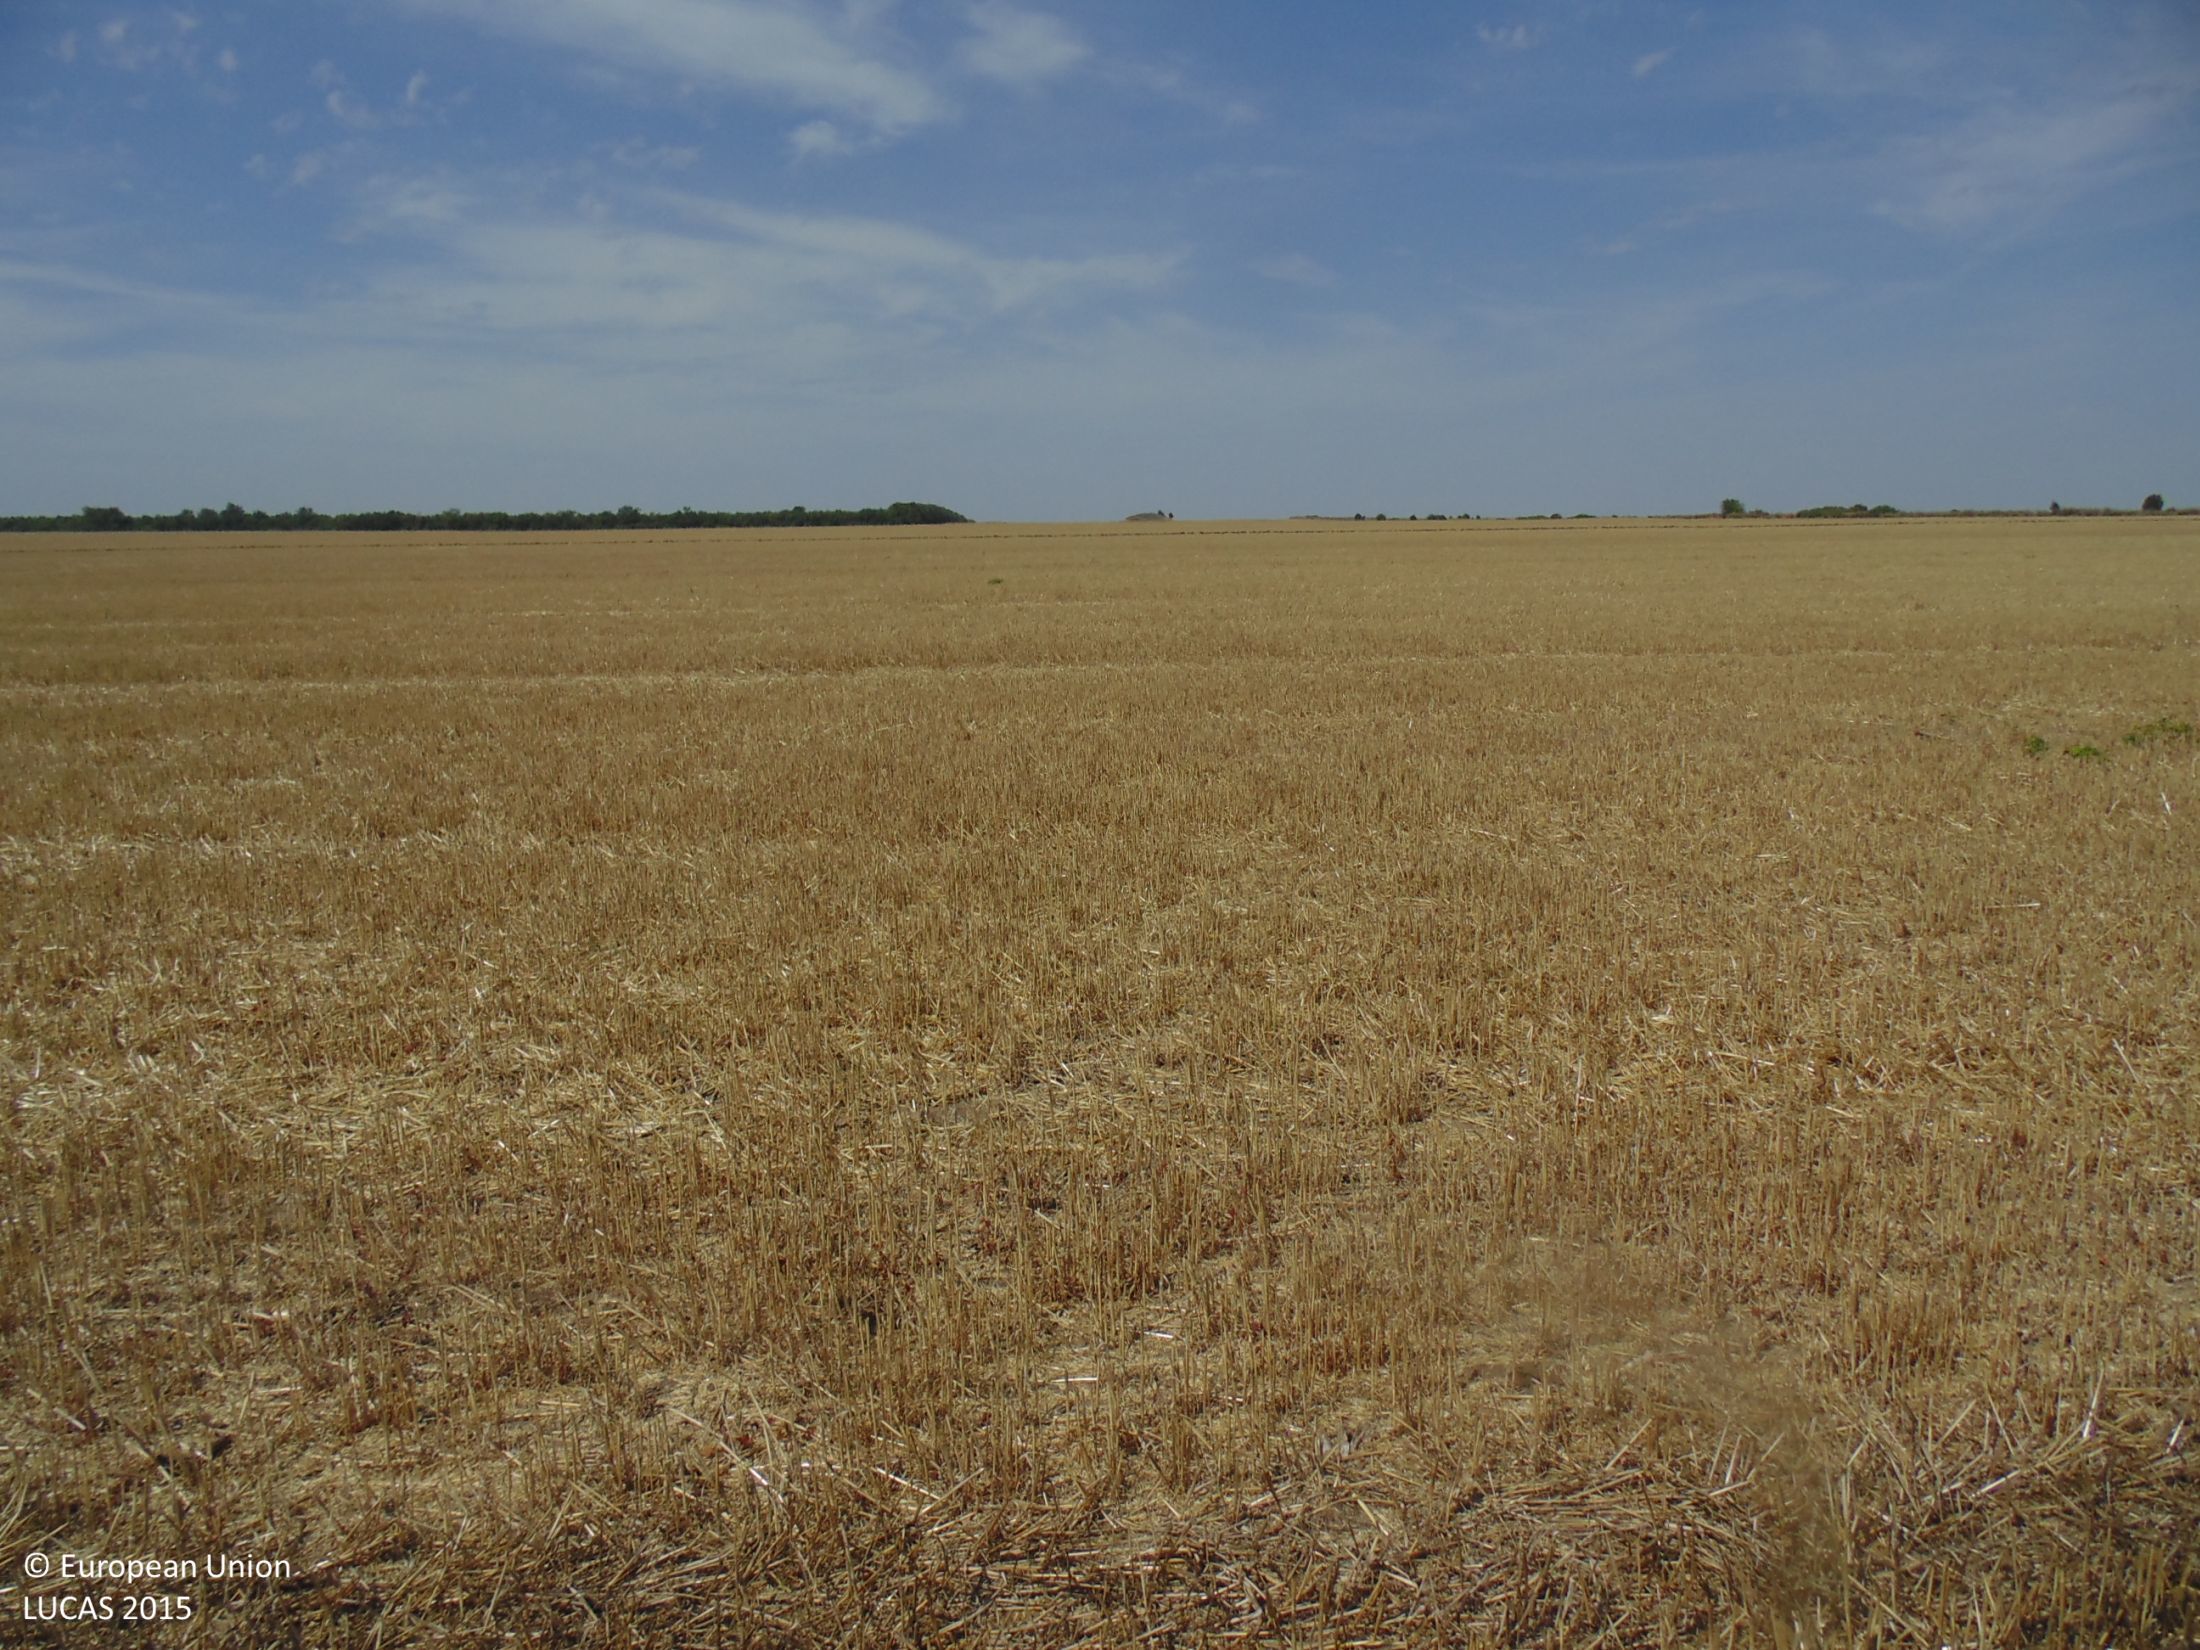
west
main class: Cropland
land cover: Common wheat
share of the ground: > 75 %
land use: Agriculture (excluding fallow land and kitchen gardens)
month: August
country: BG
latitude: 43.7352
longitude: 28.5280
